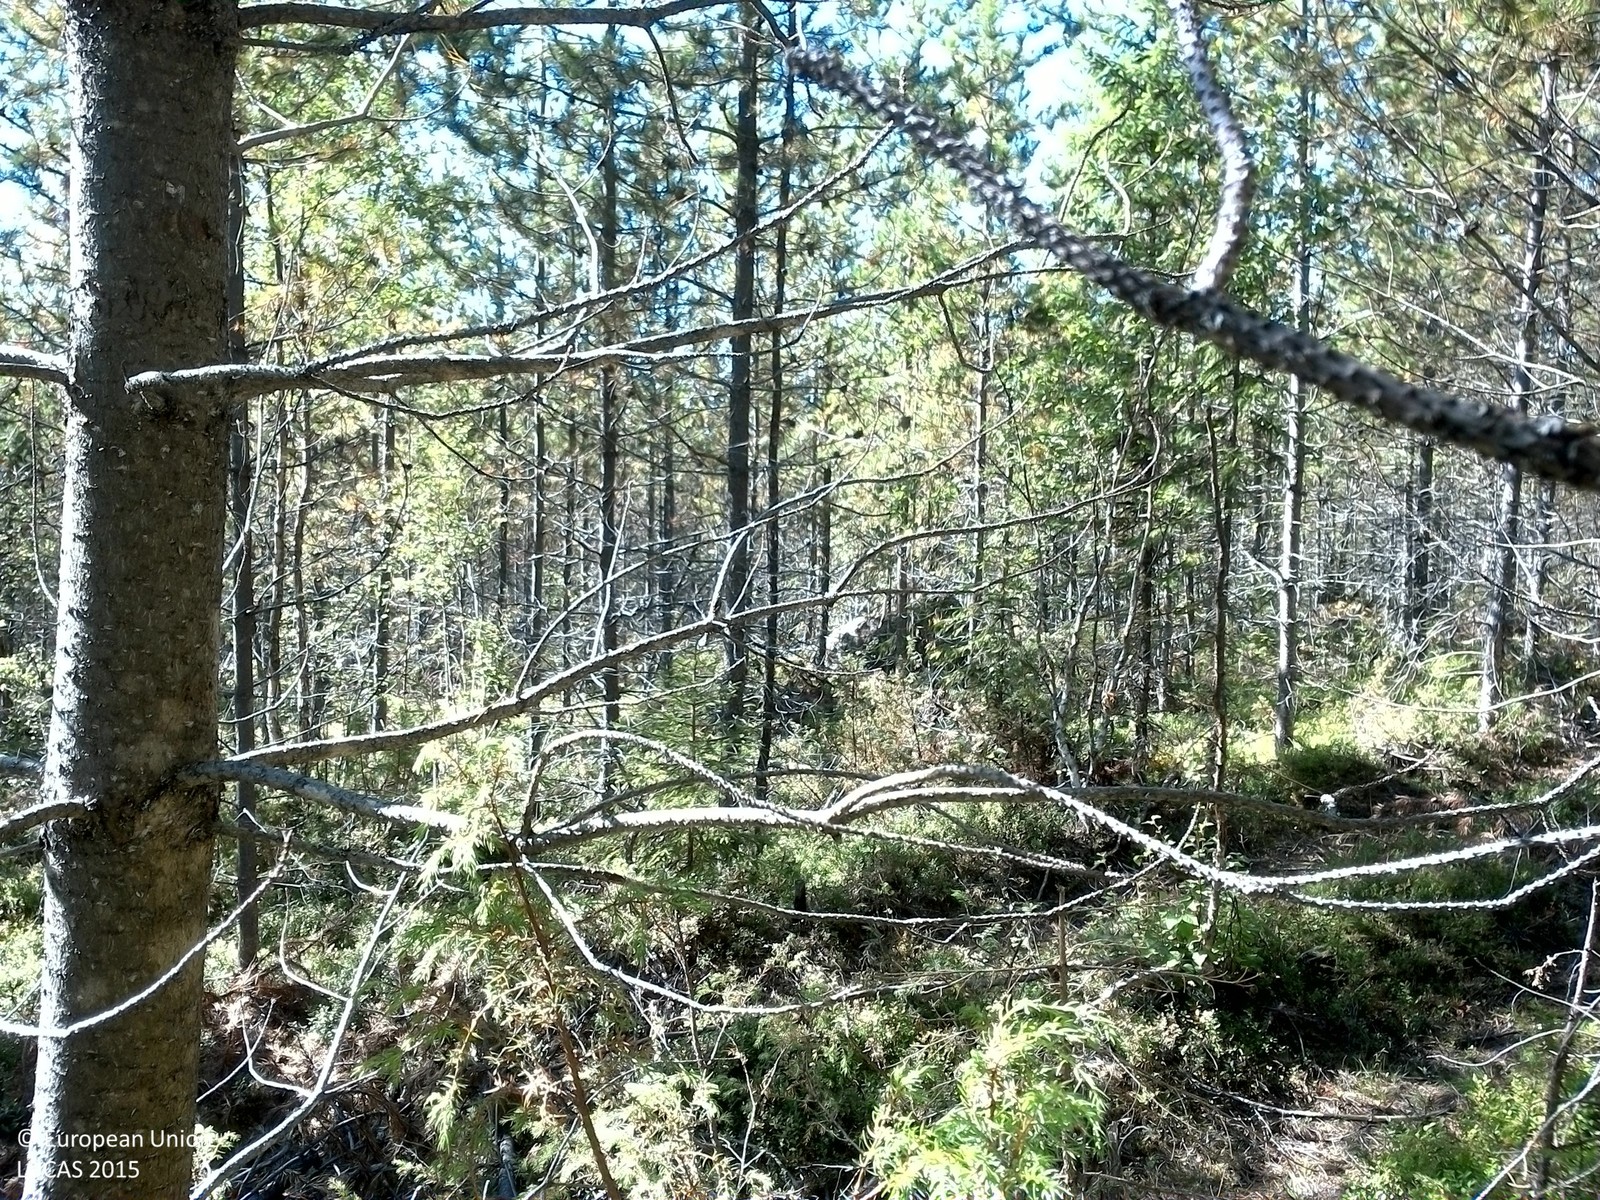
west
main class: Woodland
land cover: Pine dominated coniferous woodland
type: exotic forest
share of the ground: > 75 %
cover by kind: coniferous forest trees 85 %, shrubs 15 %
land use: Forestry
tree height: < 5 m
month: August
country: SE
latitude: 63.6720
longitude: 17.5919
